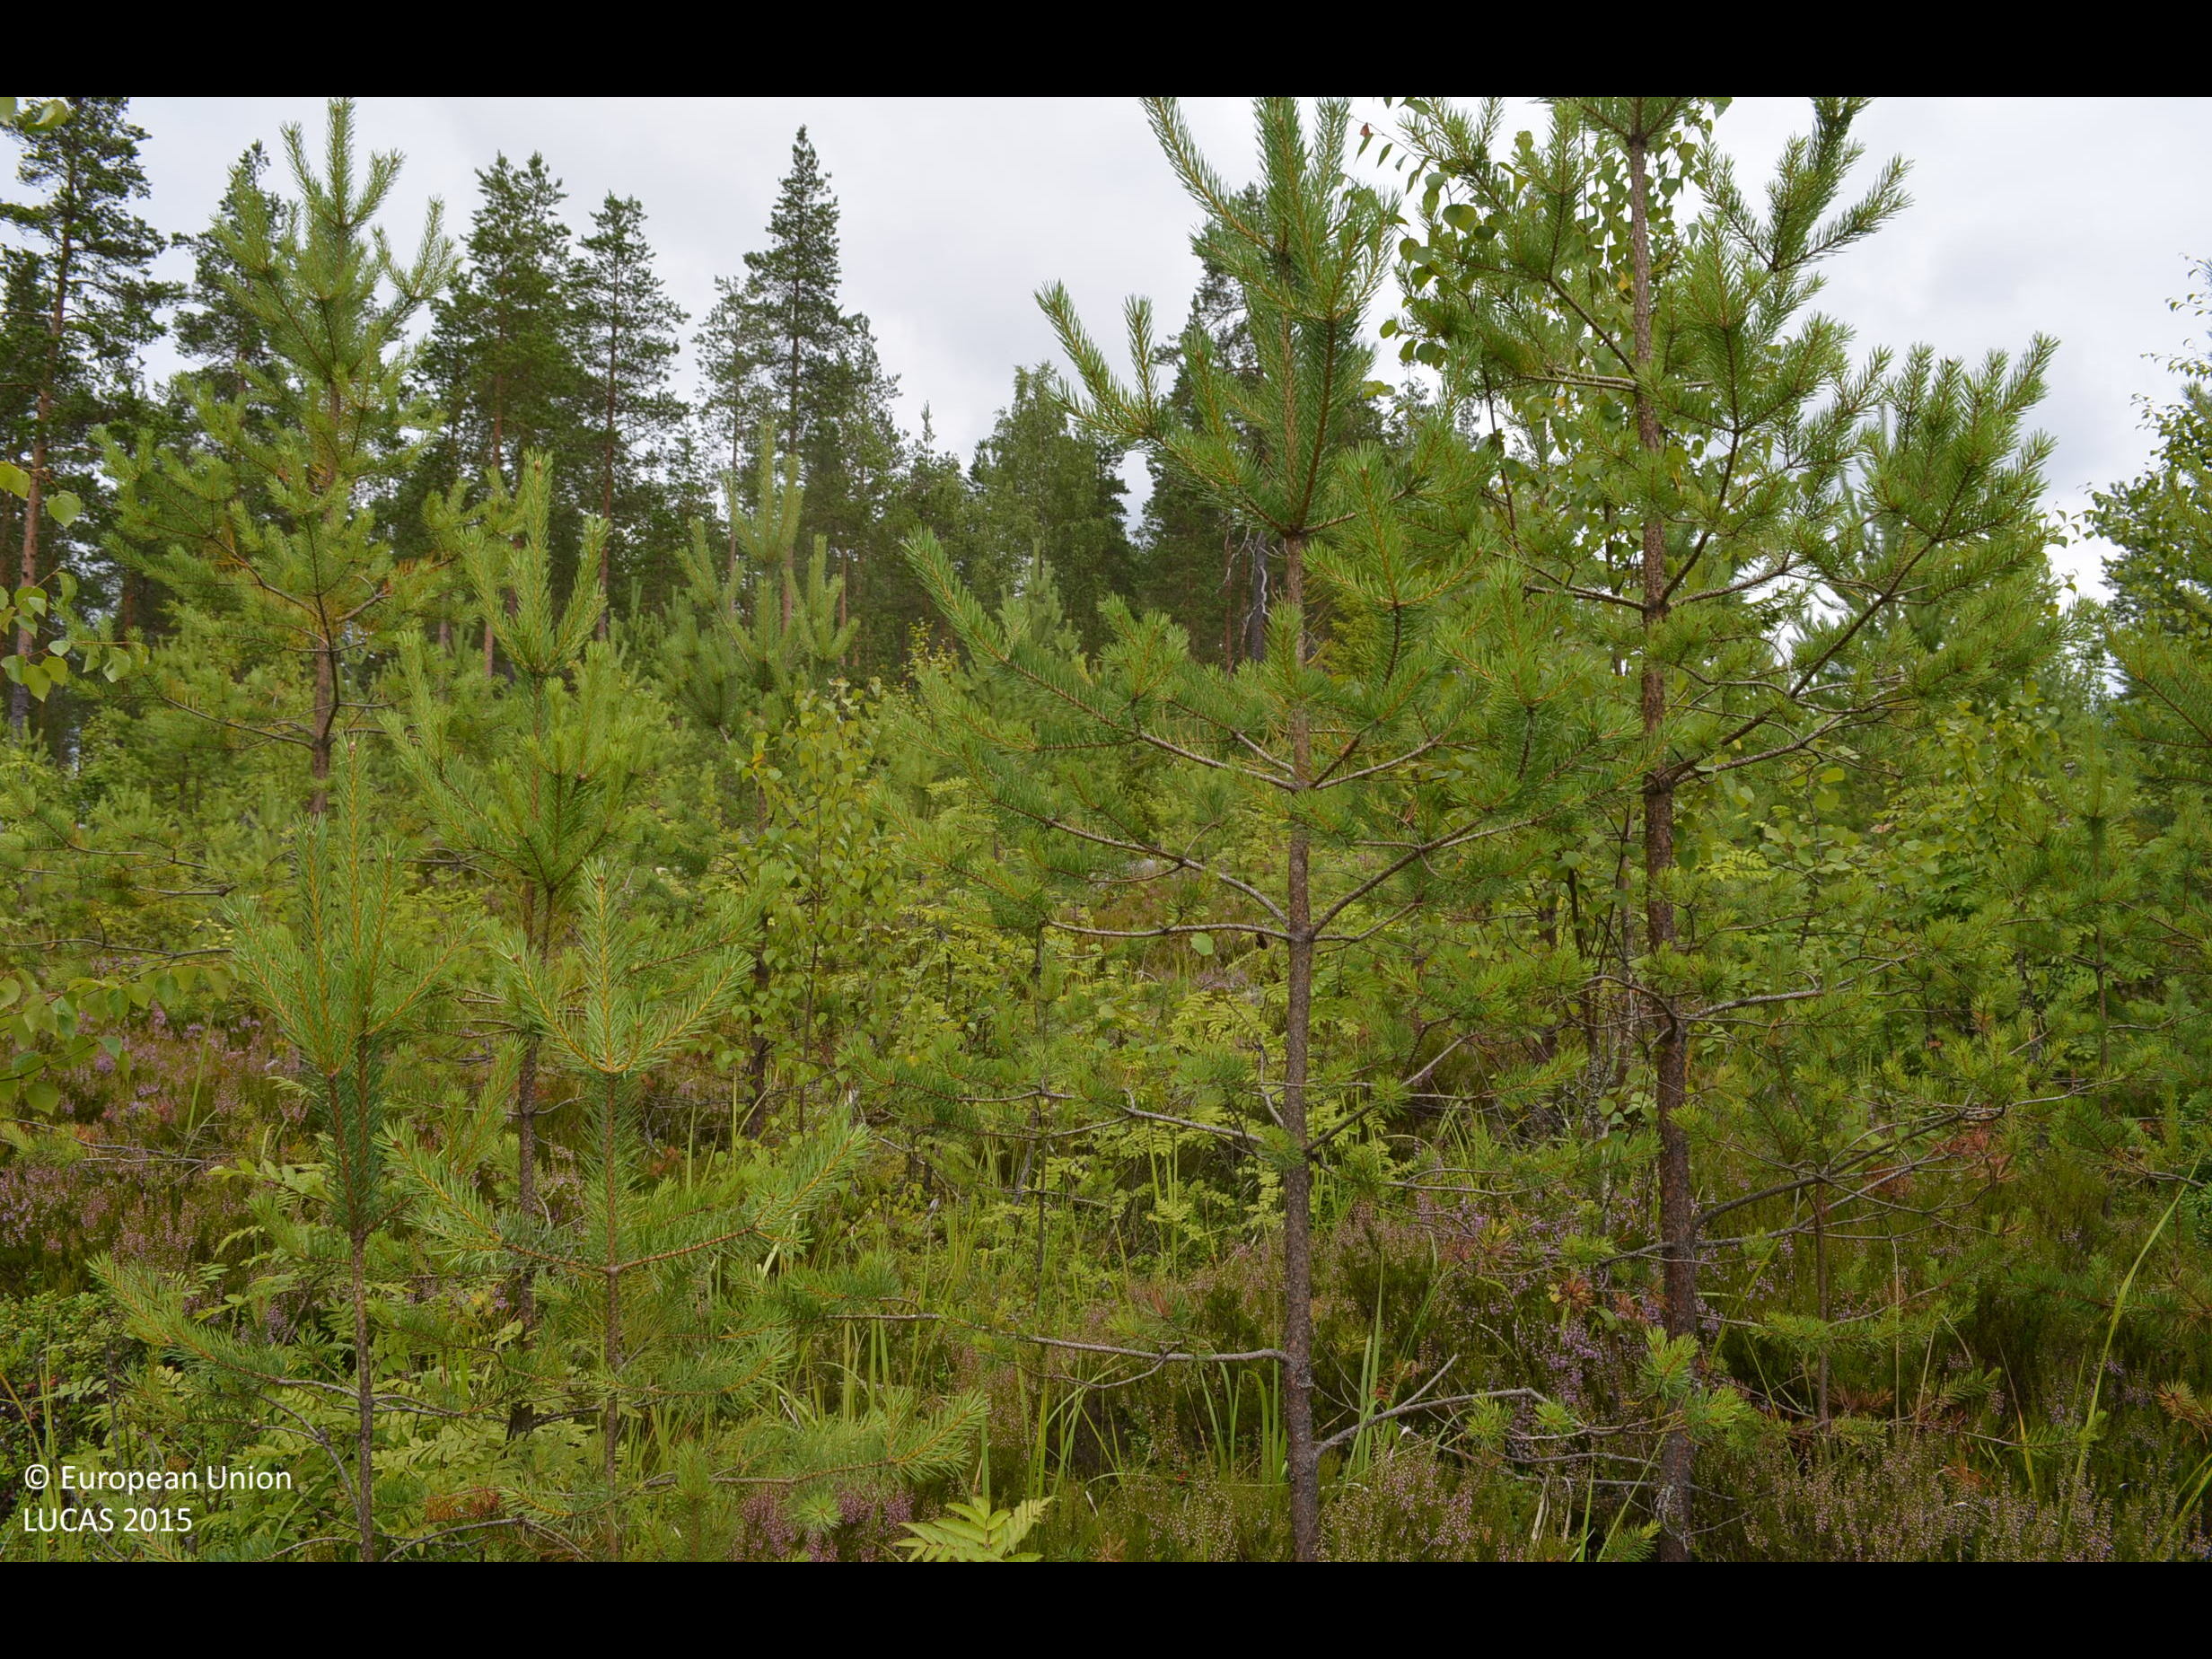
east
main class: Woodland
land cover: Pine dominated mixed woodland
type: boreal forest
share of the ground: 50 - 75 %
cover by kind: coniferous forest trees 35 %, shrubs 35 %, broadleaved forest trees 25 %, herbaceous plants 5 %
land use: Forestry
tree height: < 5 m
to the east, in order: Pine dominated mixed woodland; Pine dominated coniferous woodland; Spruce dominated coniferous woodland; Tracks; Spruce dominated coniferous woodland; Spruce dominated mixed woodland; Other coniferous woodland
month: July
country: FI
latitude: 61.9339
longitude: 24.2069
